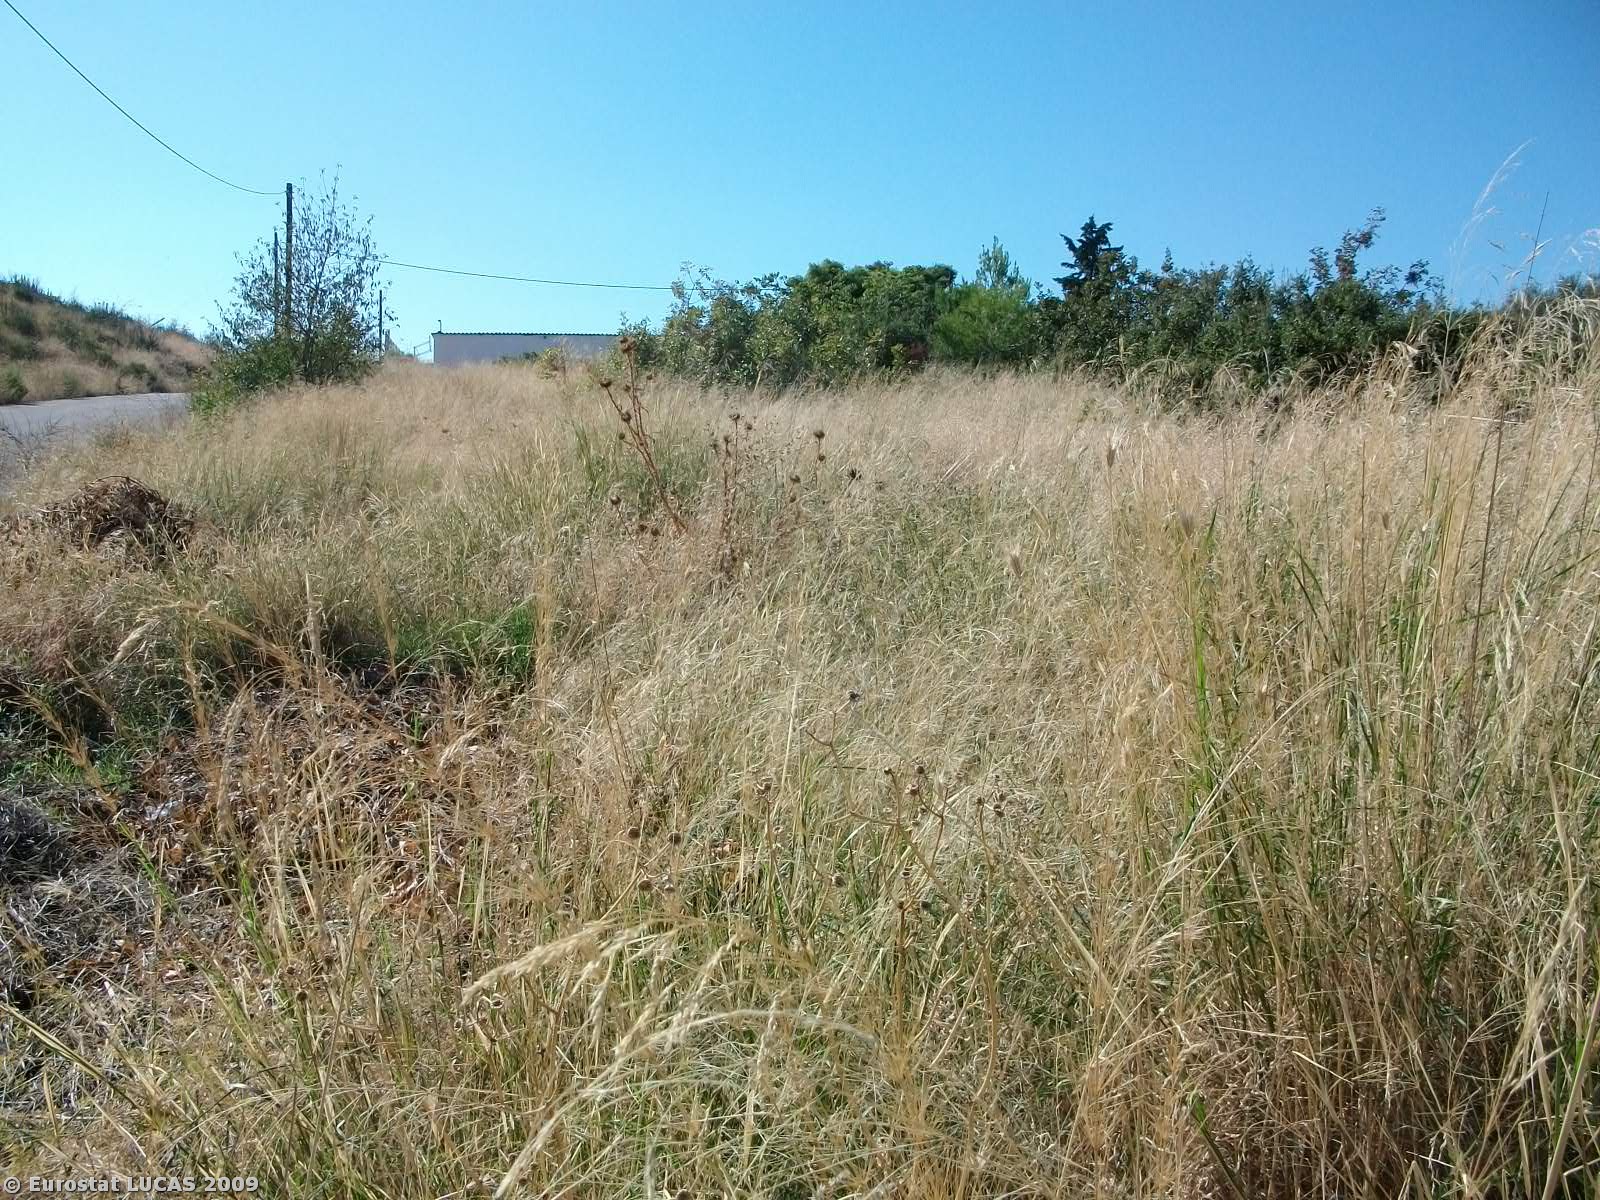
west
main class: Grassland
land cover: Grassland without tree/shrub cover
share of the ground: > 75 %
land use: Unused
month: September
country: GR
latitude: 38.2887
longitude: 23.8547
